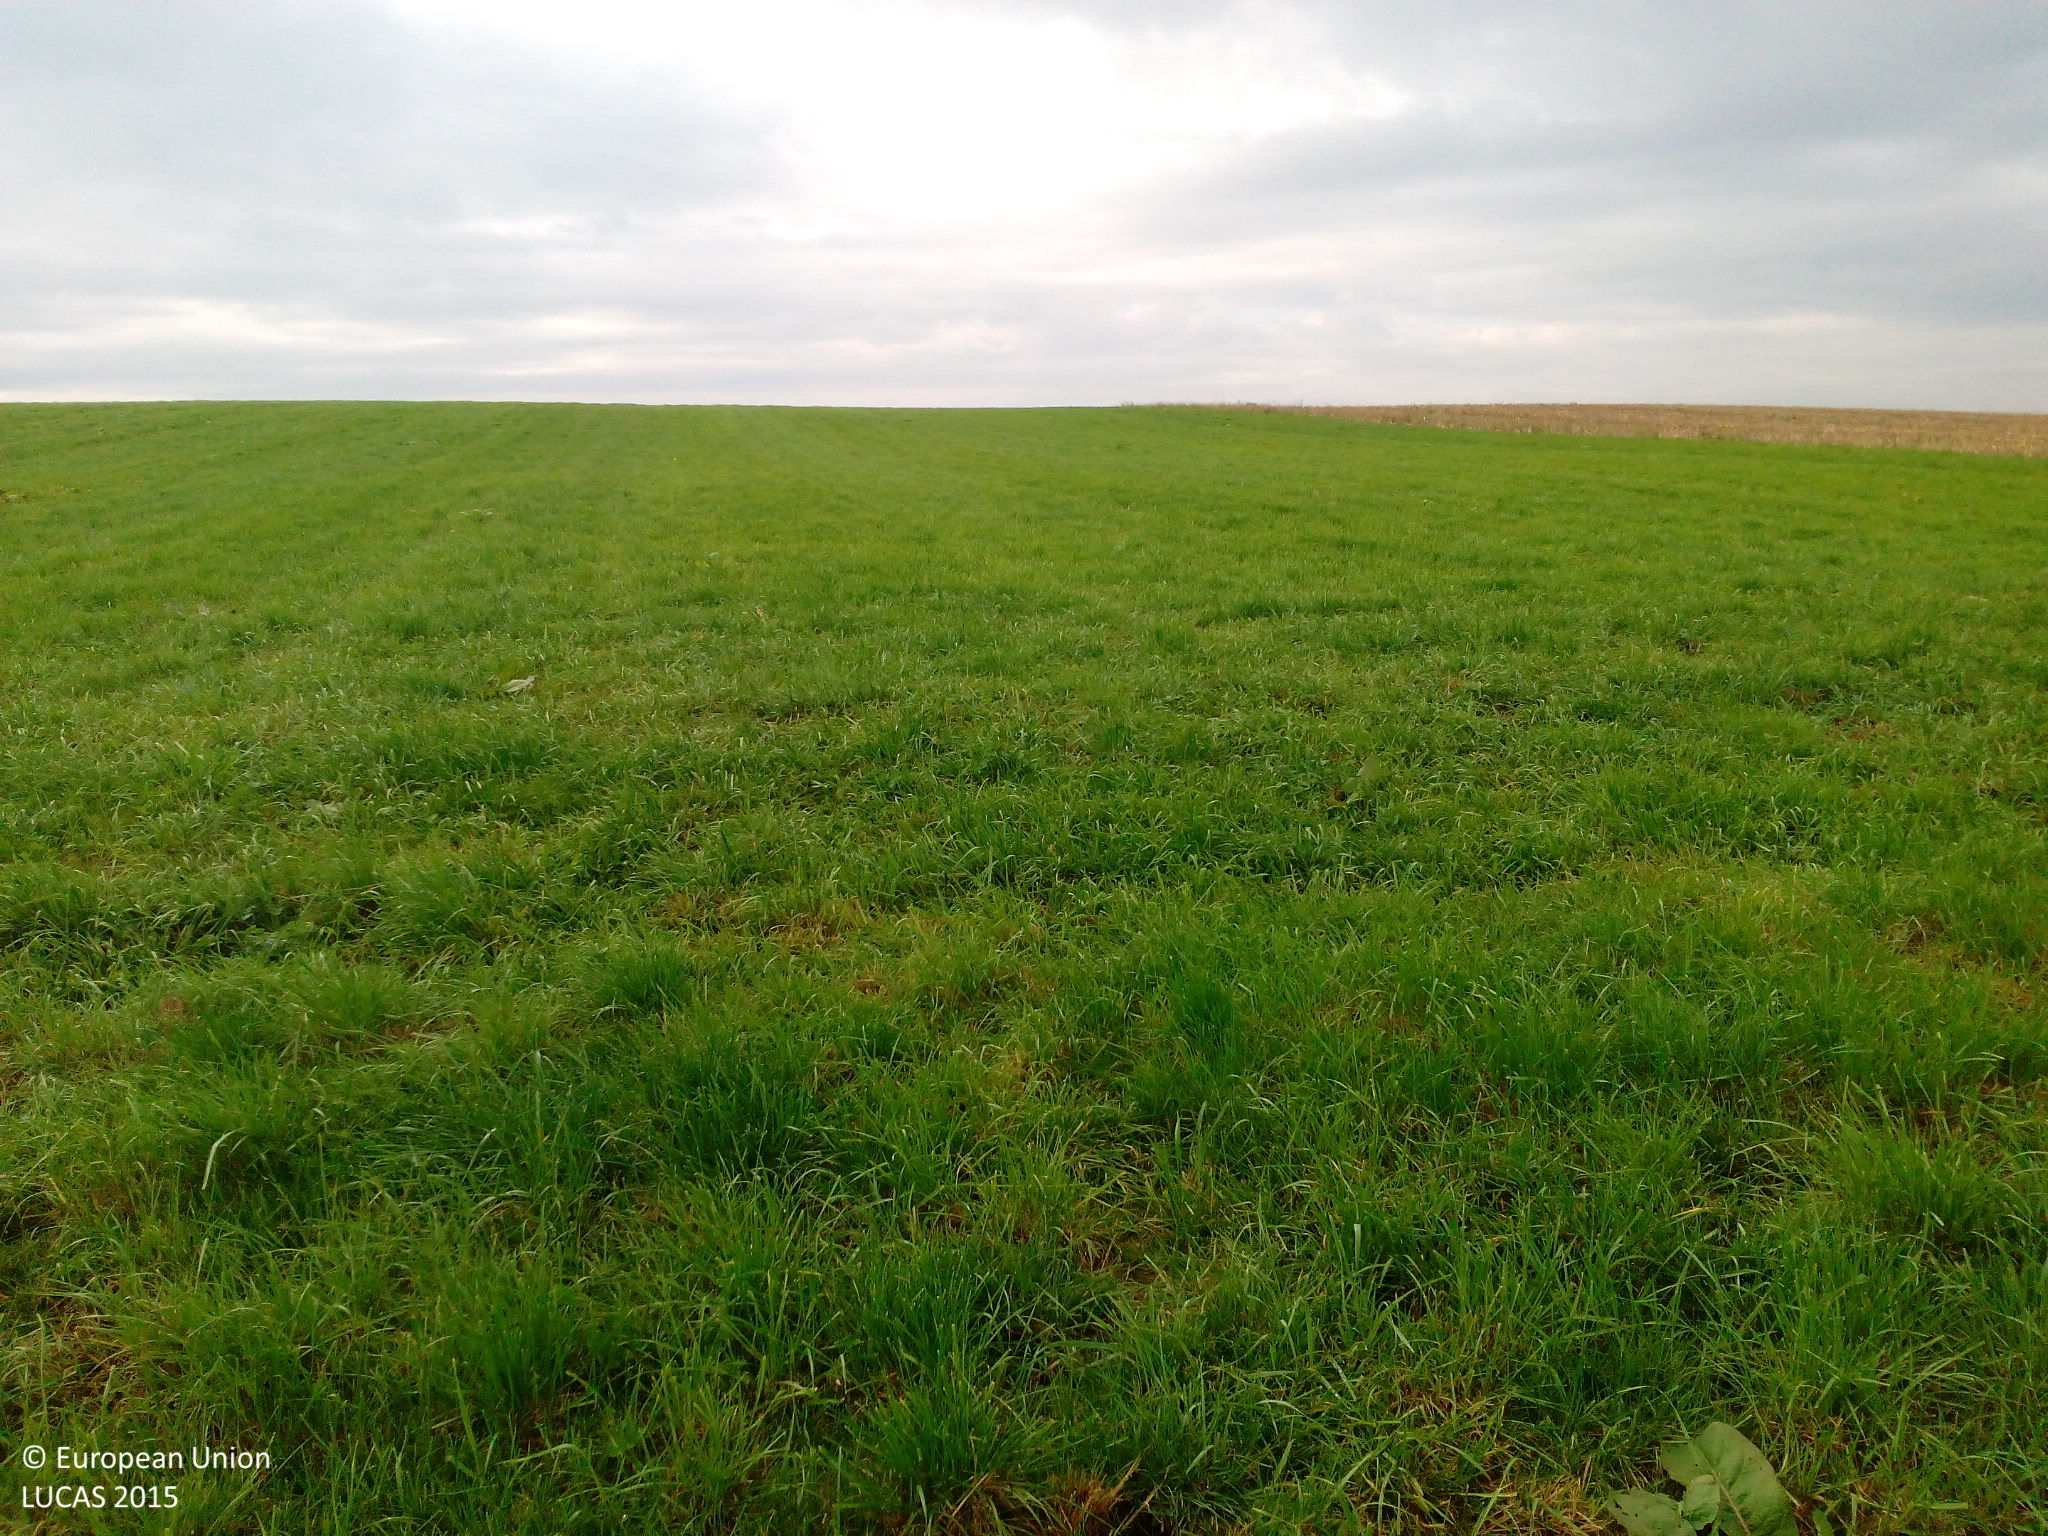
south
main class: Grassland
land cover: Grassland without tree/shrub cover
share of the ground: > 75 %
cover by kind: herbaceous plants 95 %, unconsolidated bare surface 5 %
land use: Agriculture (excluding fallow land and kitchen gardens)
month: September
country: DE
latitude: 48.3757
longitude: 11.4708
